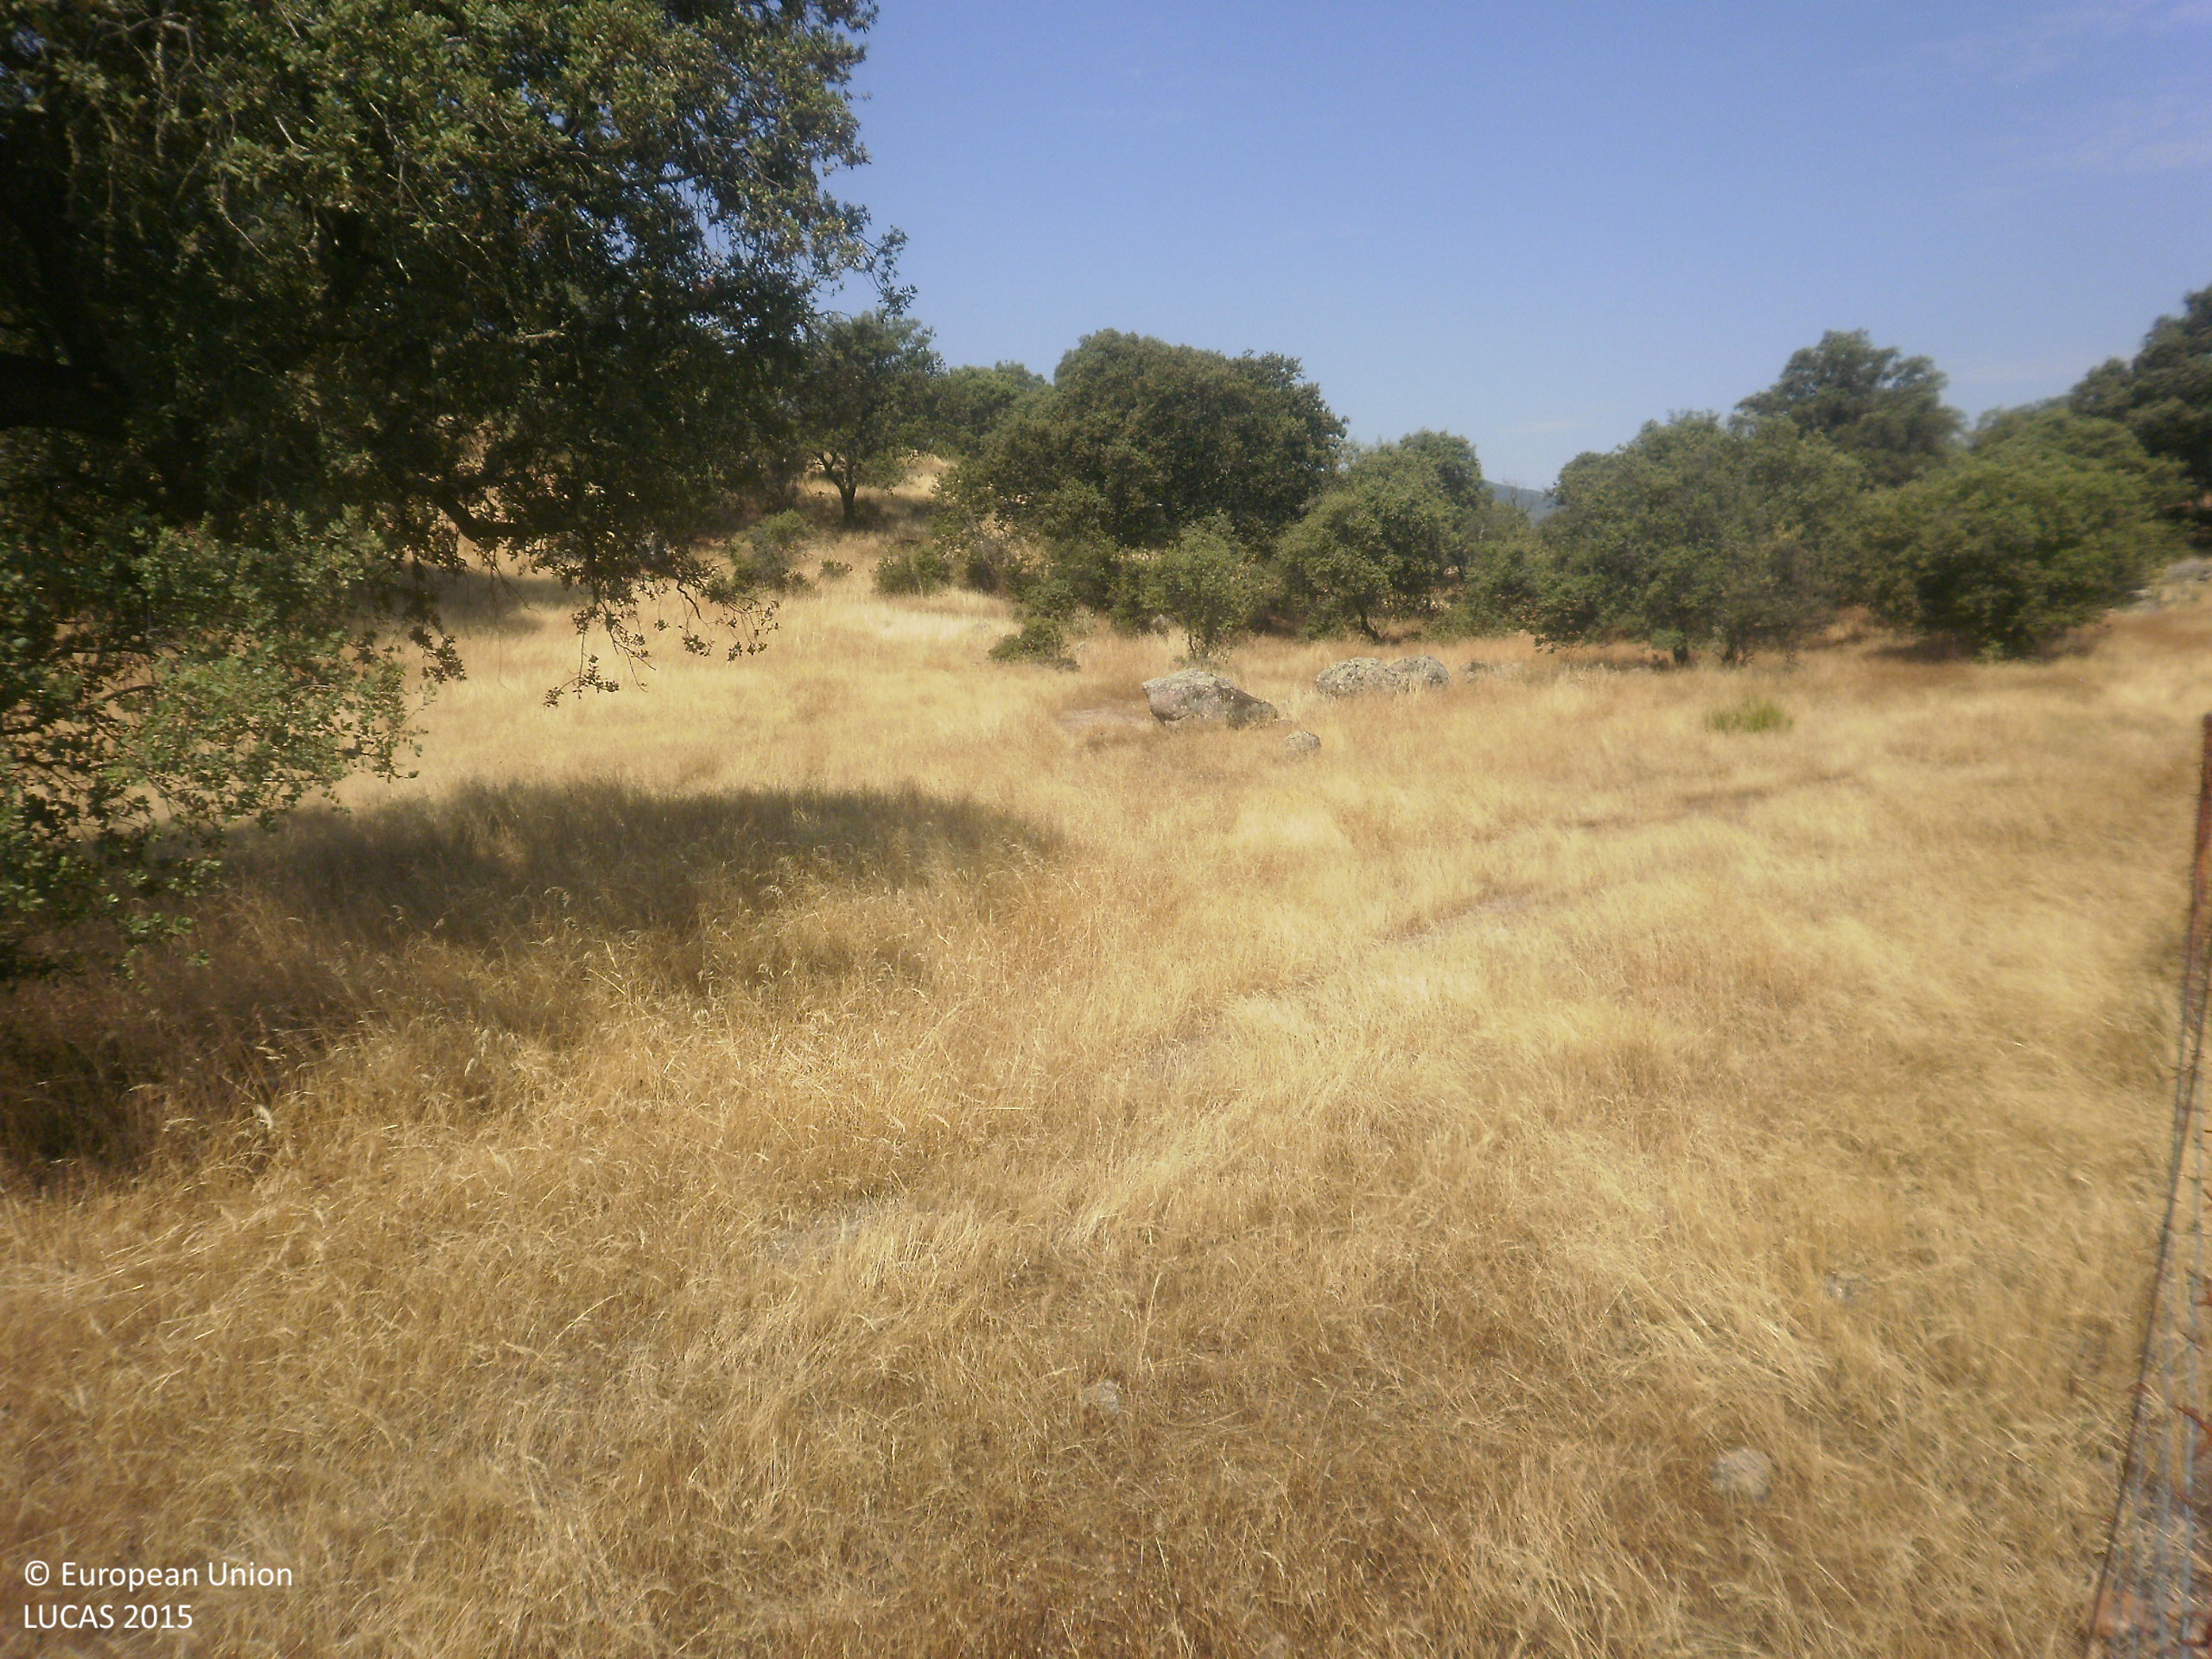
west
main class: Woodland
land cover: Broadleaved woodland
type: broadleaved evergreen forest
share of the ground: 25 - 50 %
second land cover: Grassland without tree/shrub cover
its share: > 75 %
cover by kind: herbaceous plants 70 %, broadleaved forest trees 30 %
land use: Forestry
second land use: Agriculture (excluding fallow land and kitchen gardens)
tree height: > 5 m
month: June
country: ES
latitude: 39.2097
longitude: -5.9560
